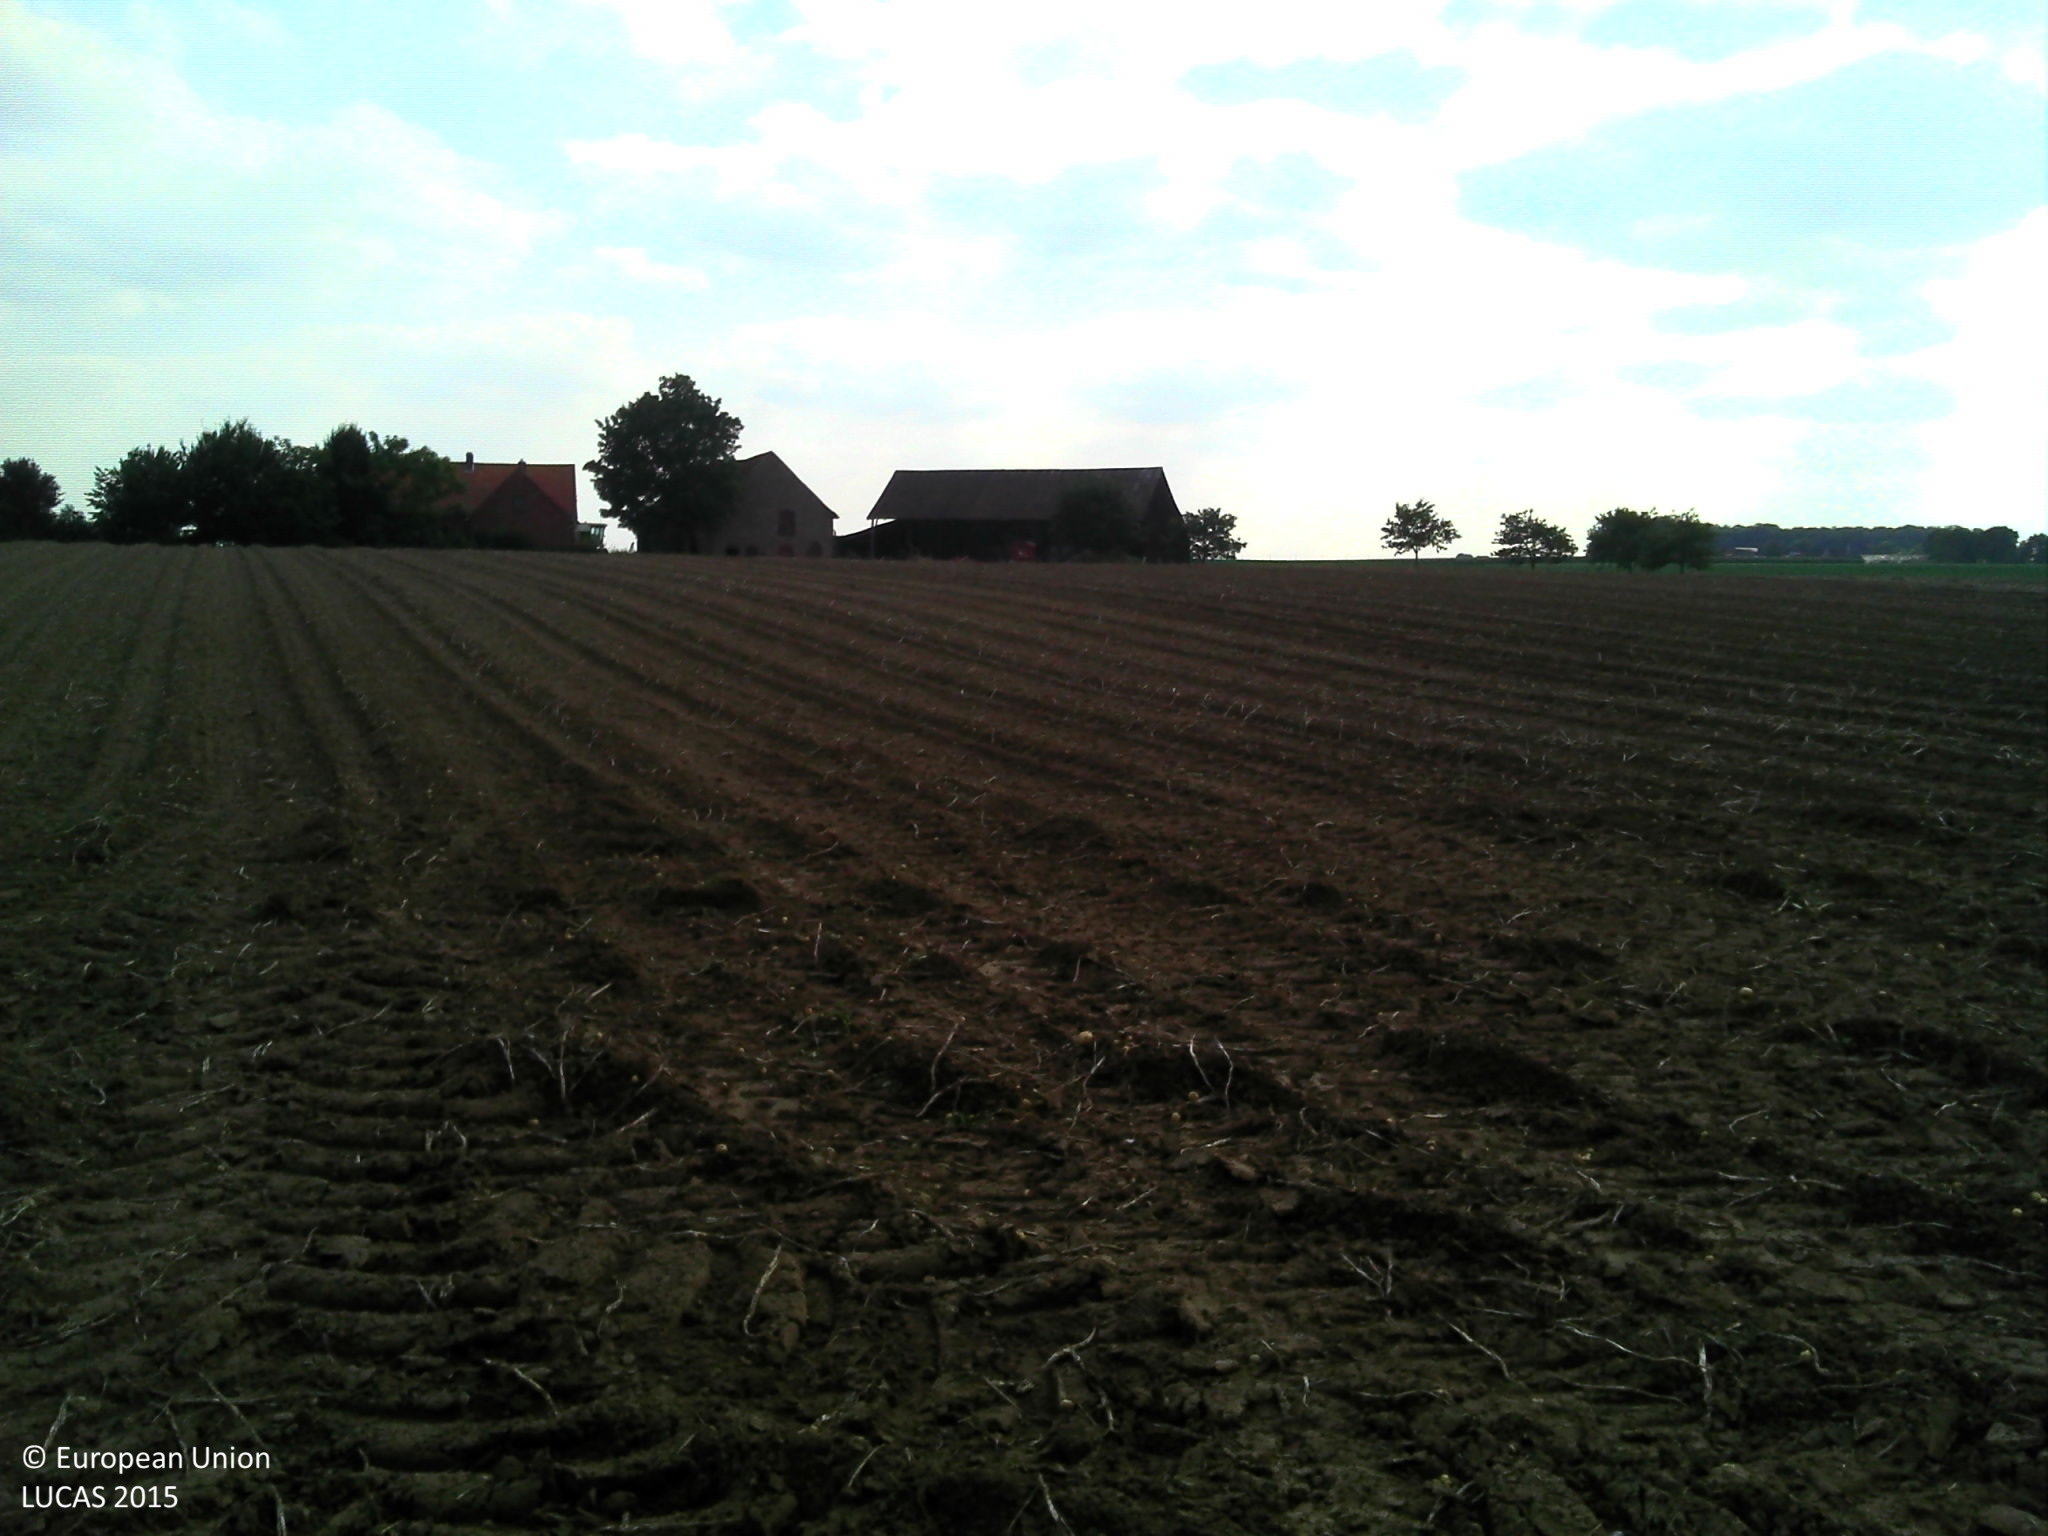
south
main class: Cropland
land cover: Potatoes
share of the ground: < 10 %
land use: Agriculture (excluding fallow land and kitchen gardens)
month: September
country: BE
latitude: 50.8923
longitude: 2.7523
